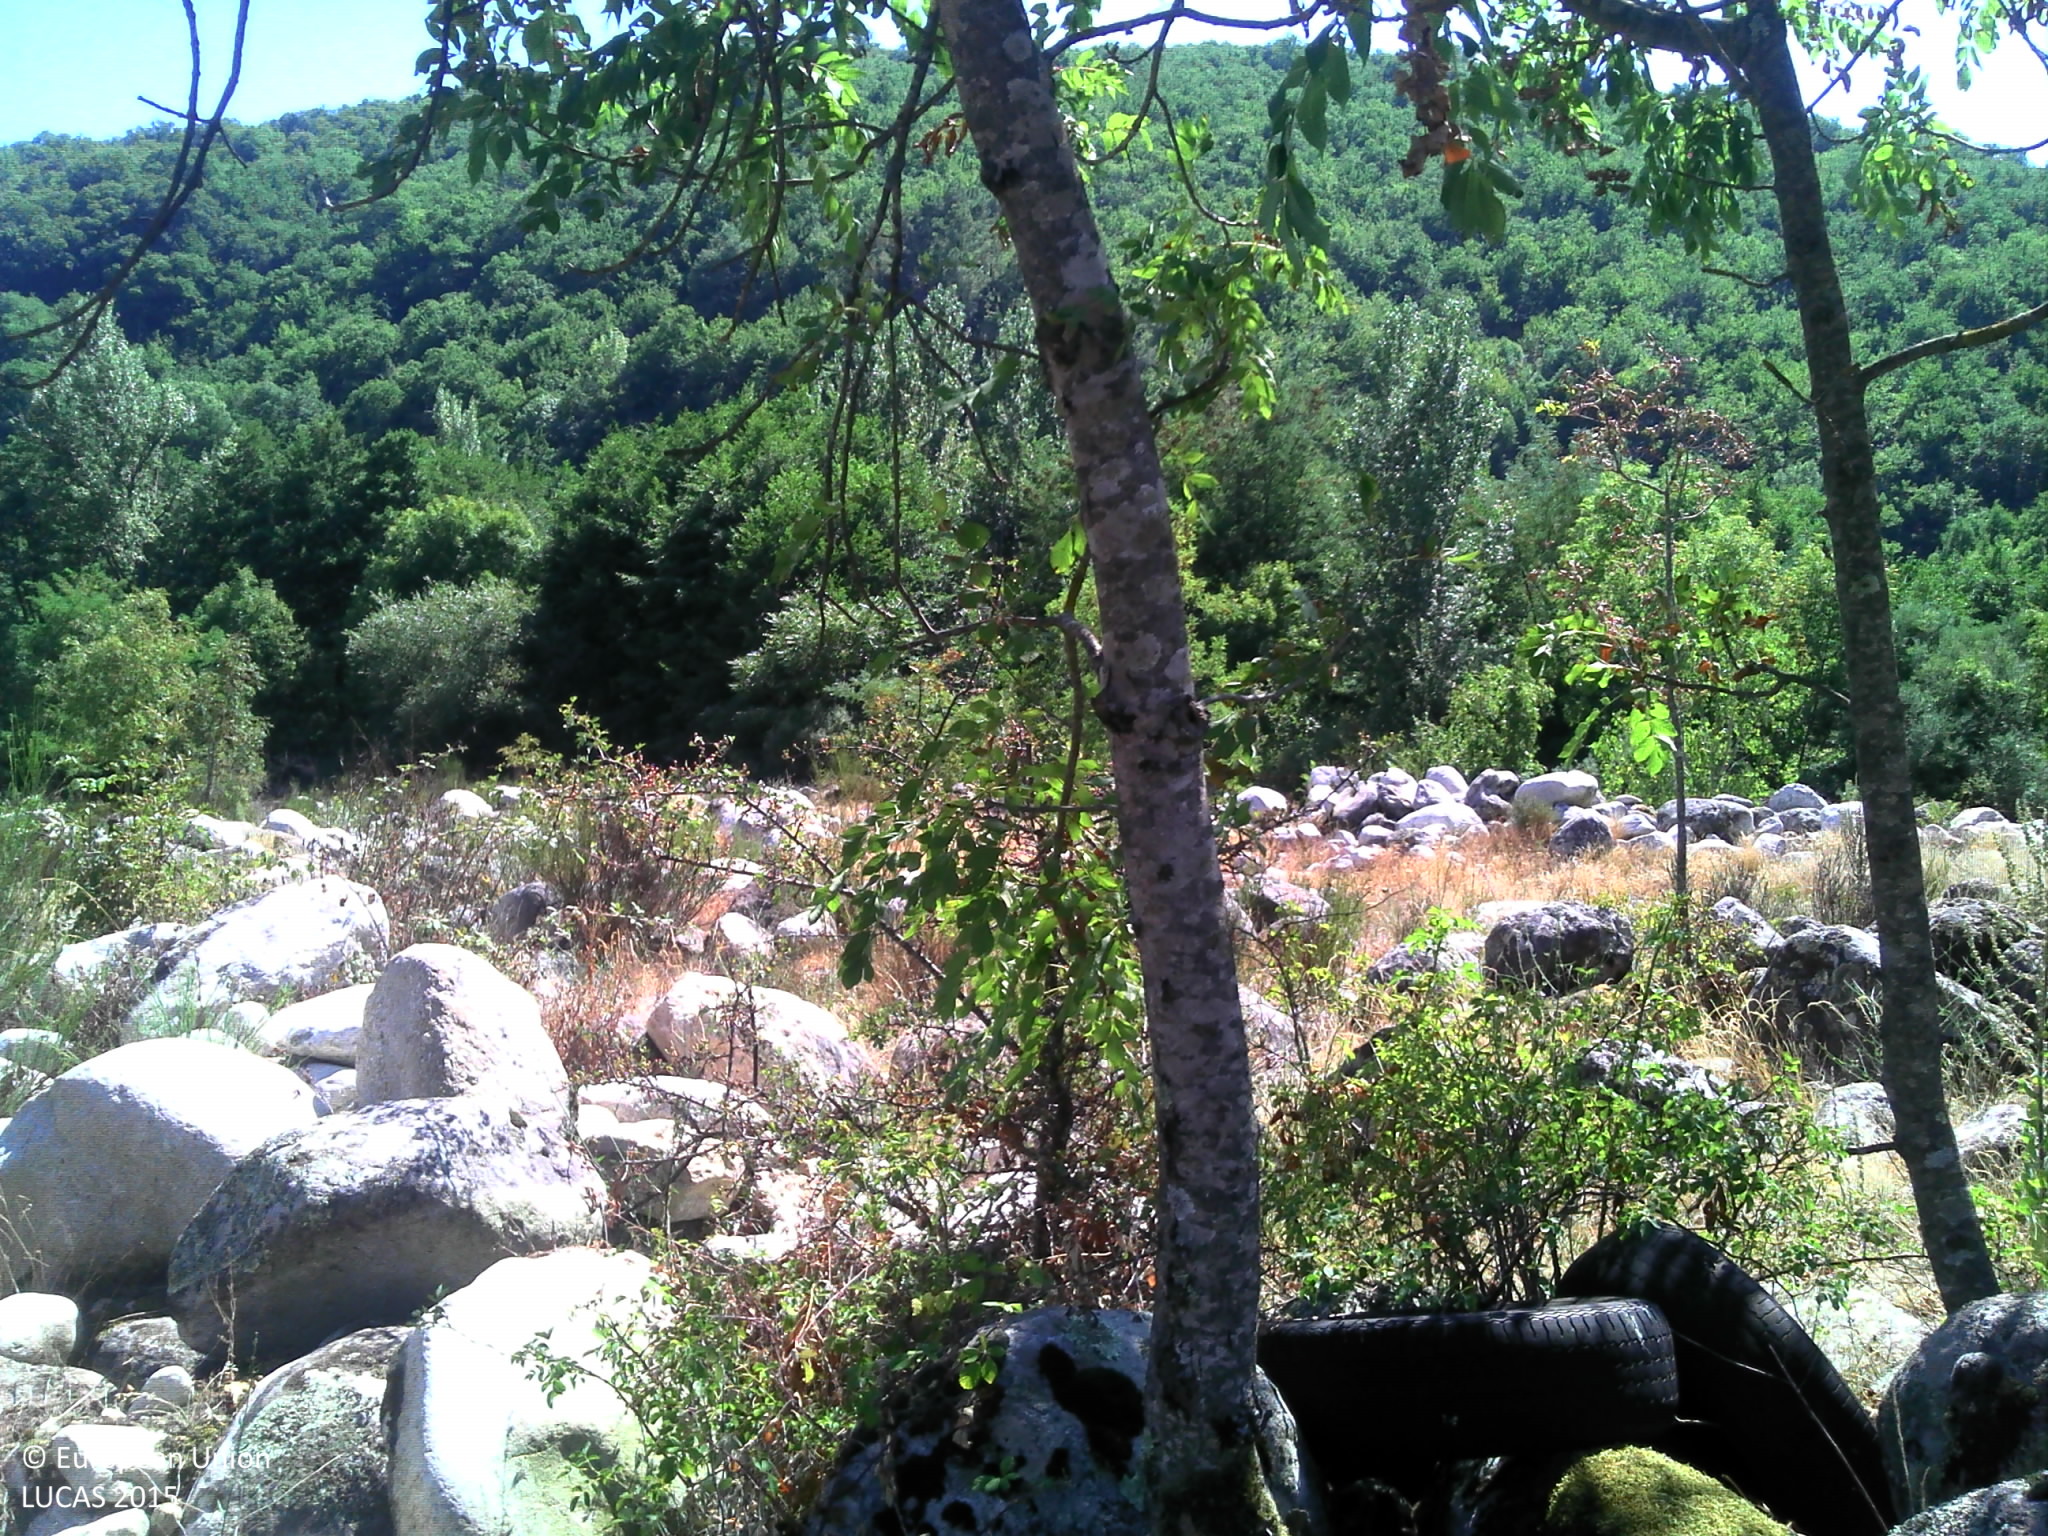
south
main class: Grassland
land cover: Grassland with sparse tree/shrub cover
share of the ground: > 75 %
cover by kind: herbaceous plants 85 %, broadleaved forest trees 5 %, shrubs 5 %
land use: Semi-natural and natural areas not in use
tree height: < 5 m
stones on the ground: 10 - 25 %
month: August
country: FR
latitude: 44.6233
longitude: 4.2210
